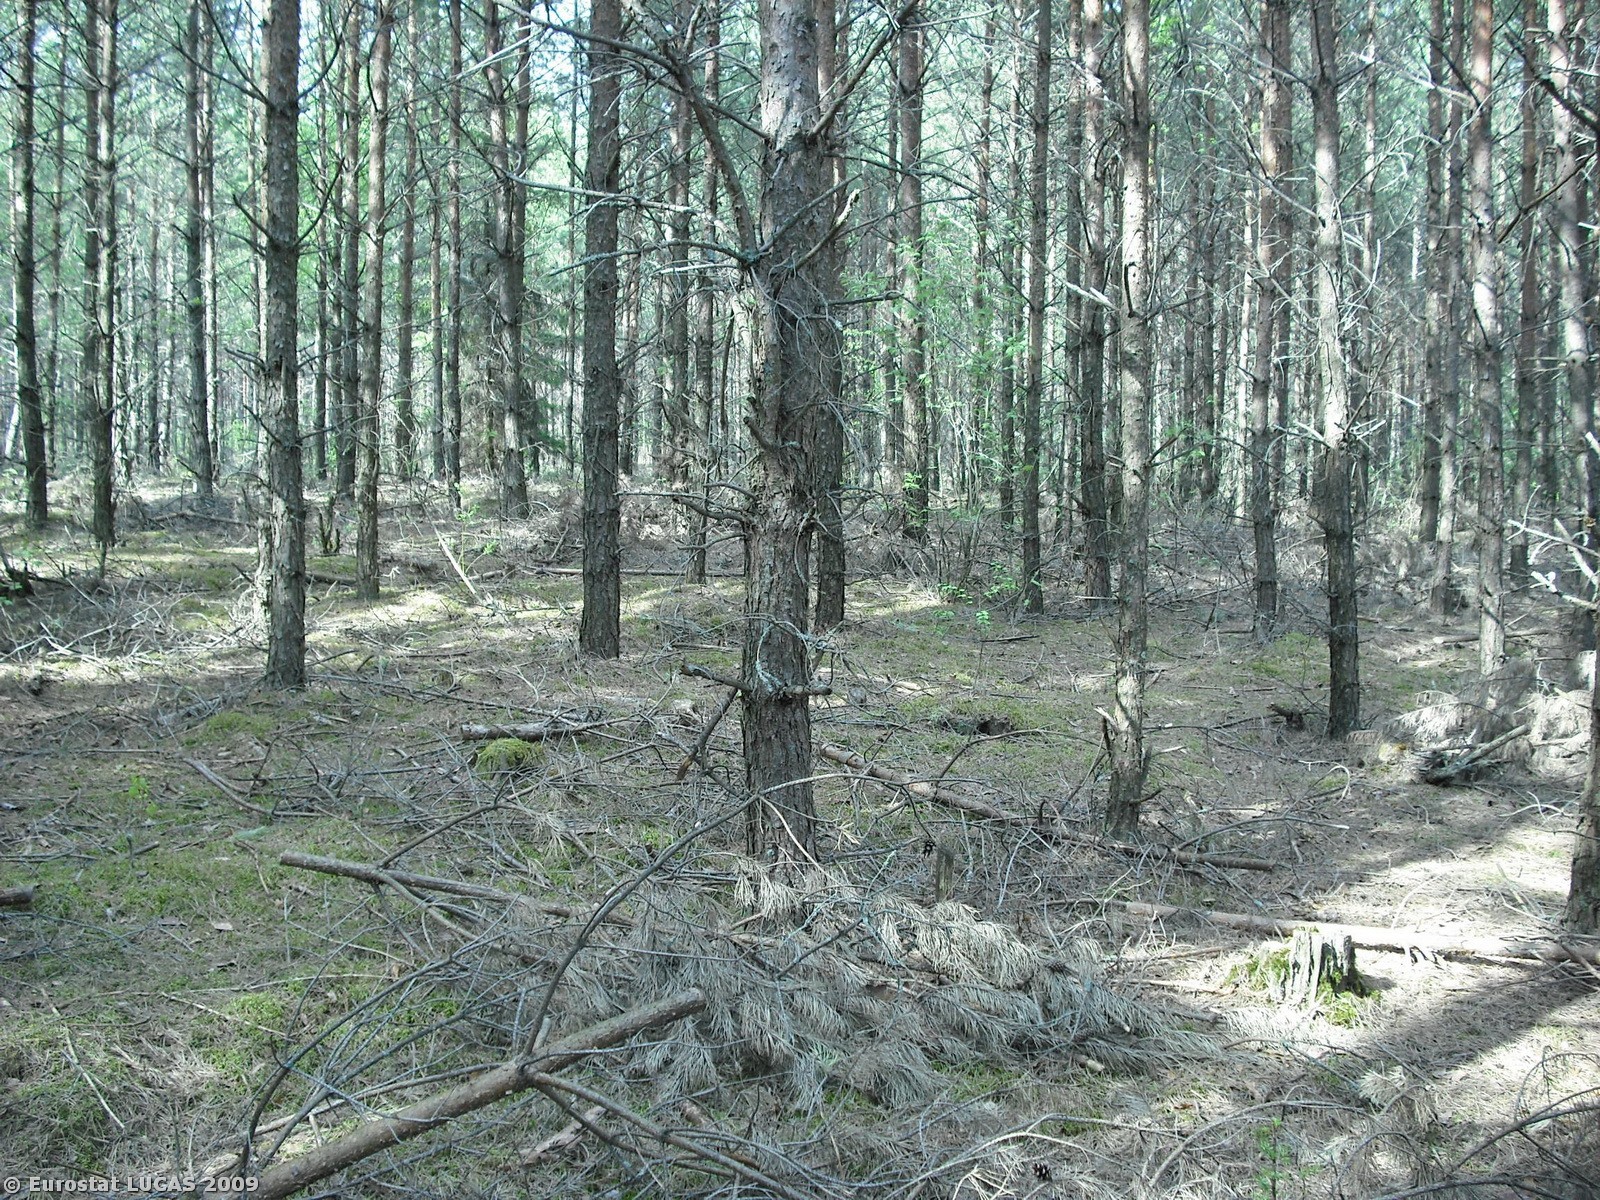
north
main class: Woodland
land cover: Coniferous woodland
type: hemiboreal forest and nemoral coniferous forest and mixed broadleaved-coniferous forest
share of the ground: > 75 %
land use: Forestry
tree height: > 5 m
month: May
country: PL
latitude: 53.0687
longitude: 23.5923
